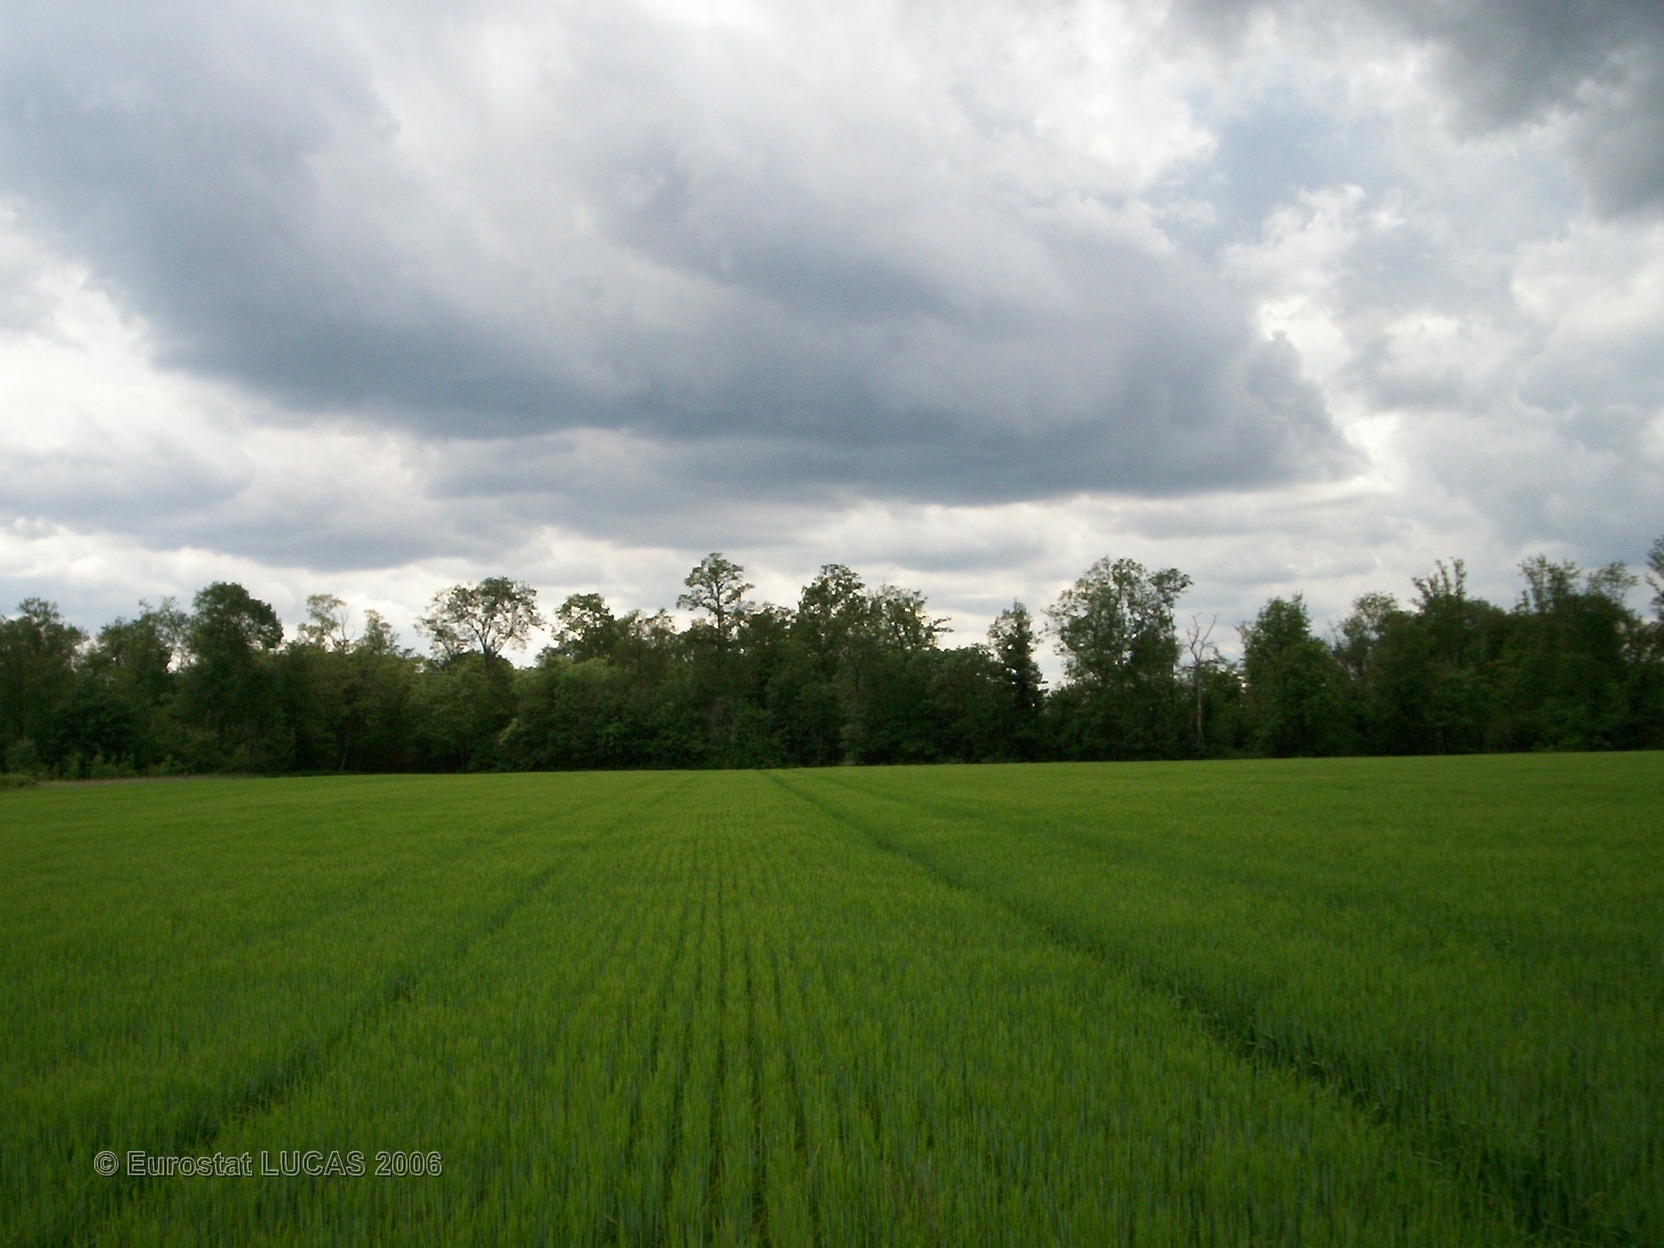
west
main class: Cropland
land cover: Barley
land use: Agriculture (excluding fallow land and kitchen gardens)
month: May
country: FR
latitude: 48.5675
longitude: 2.8220
